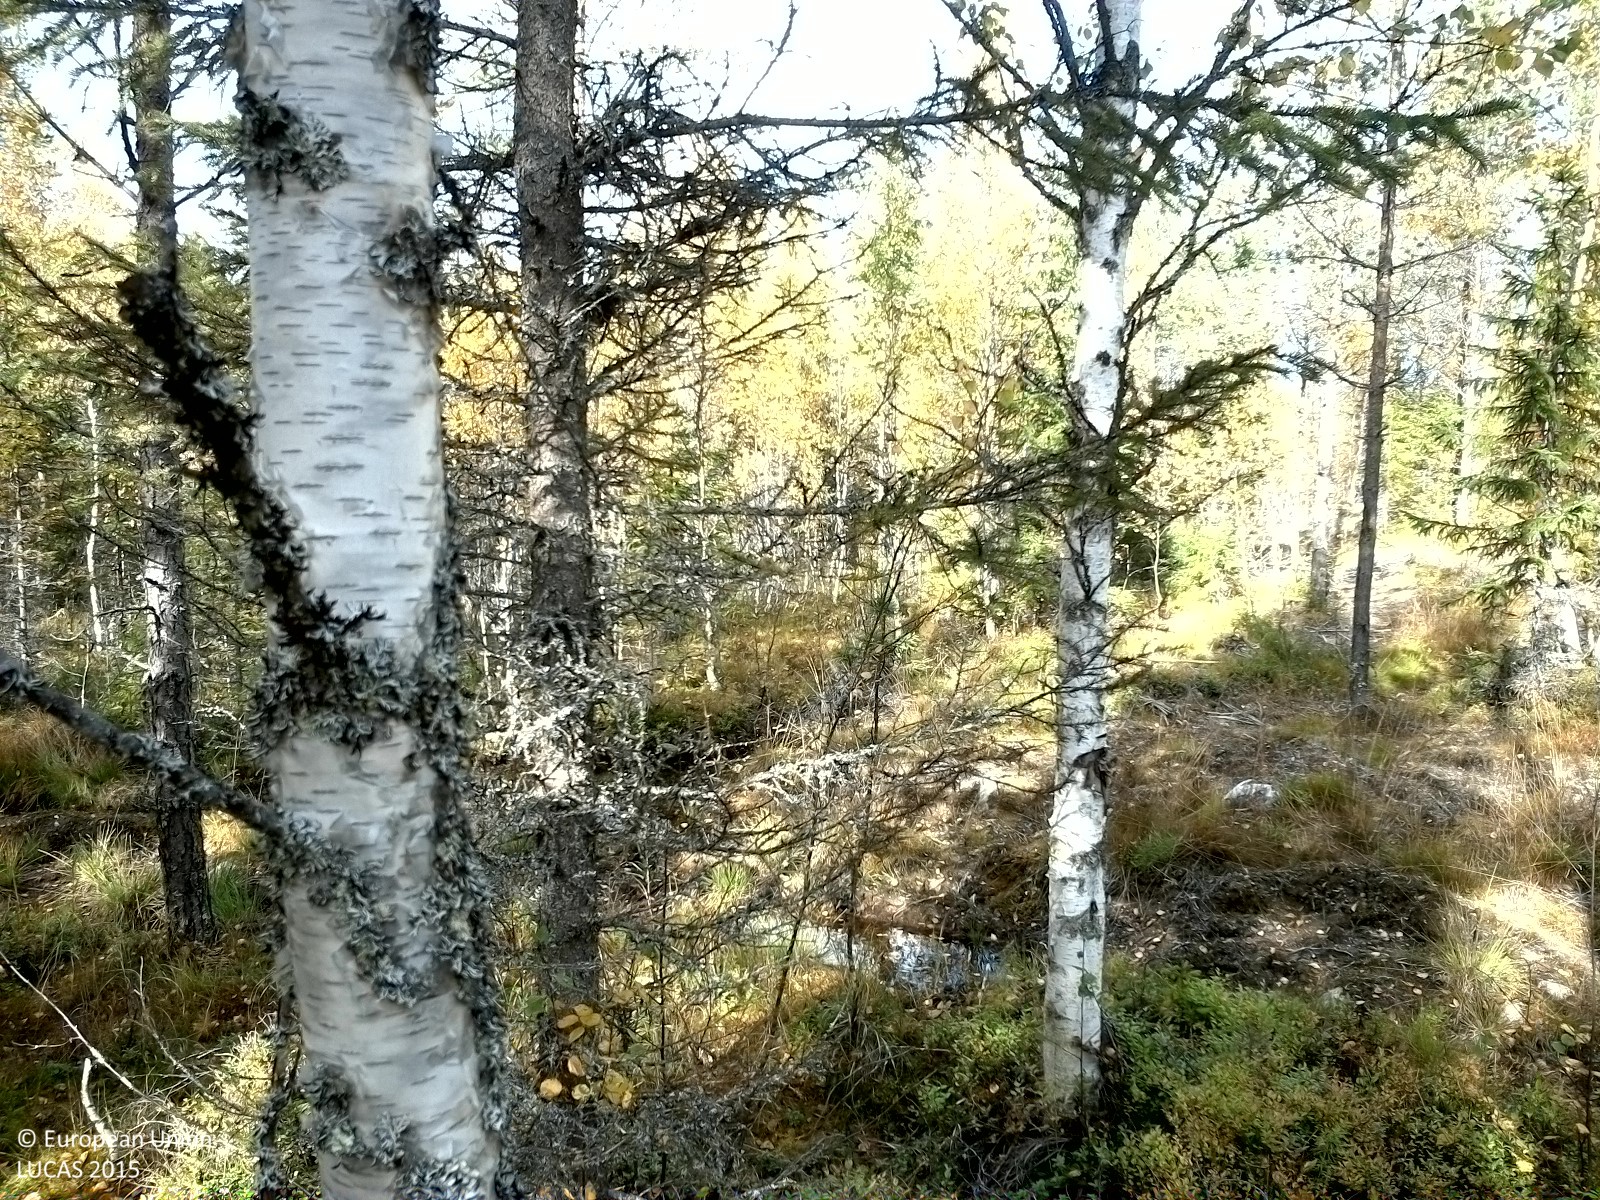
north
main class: Woodland
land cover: Spruce dominated mixed woodland
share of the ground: 50 - 75 %
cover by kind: broadleaved forest trees 35 %, lichens and mosses 30 %, shrubs 20 %, coniferous forest trees 15 %
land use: Forestry
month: September
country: SE
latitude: 62.1025
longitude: 15.3268
